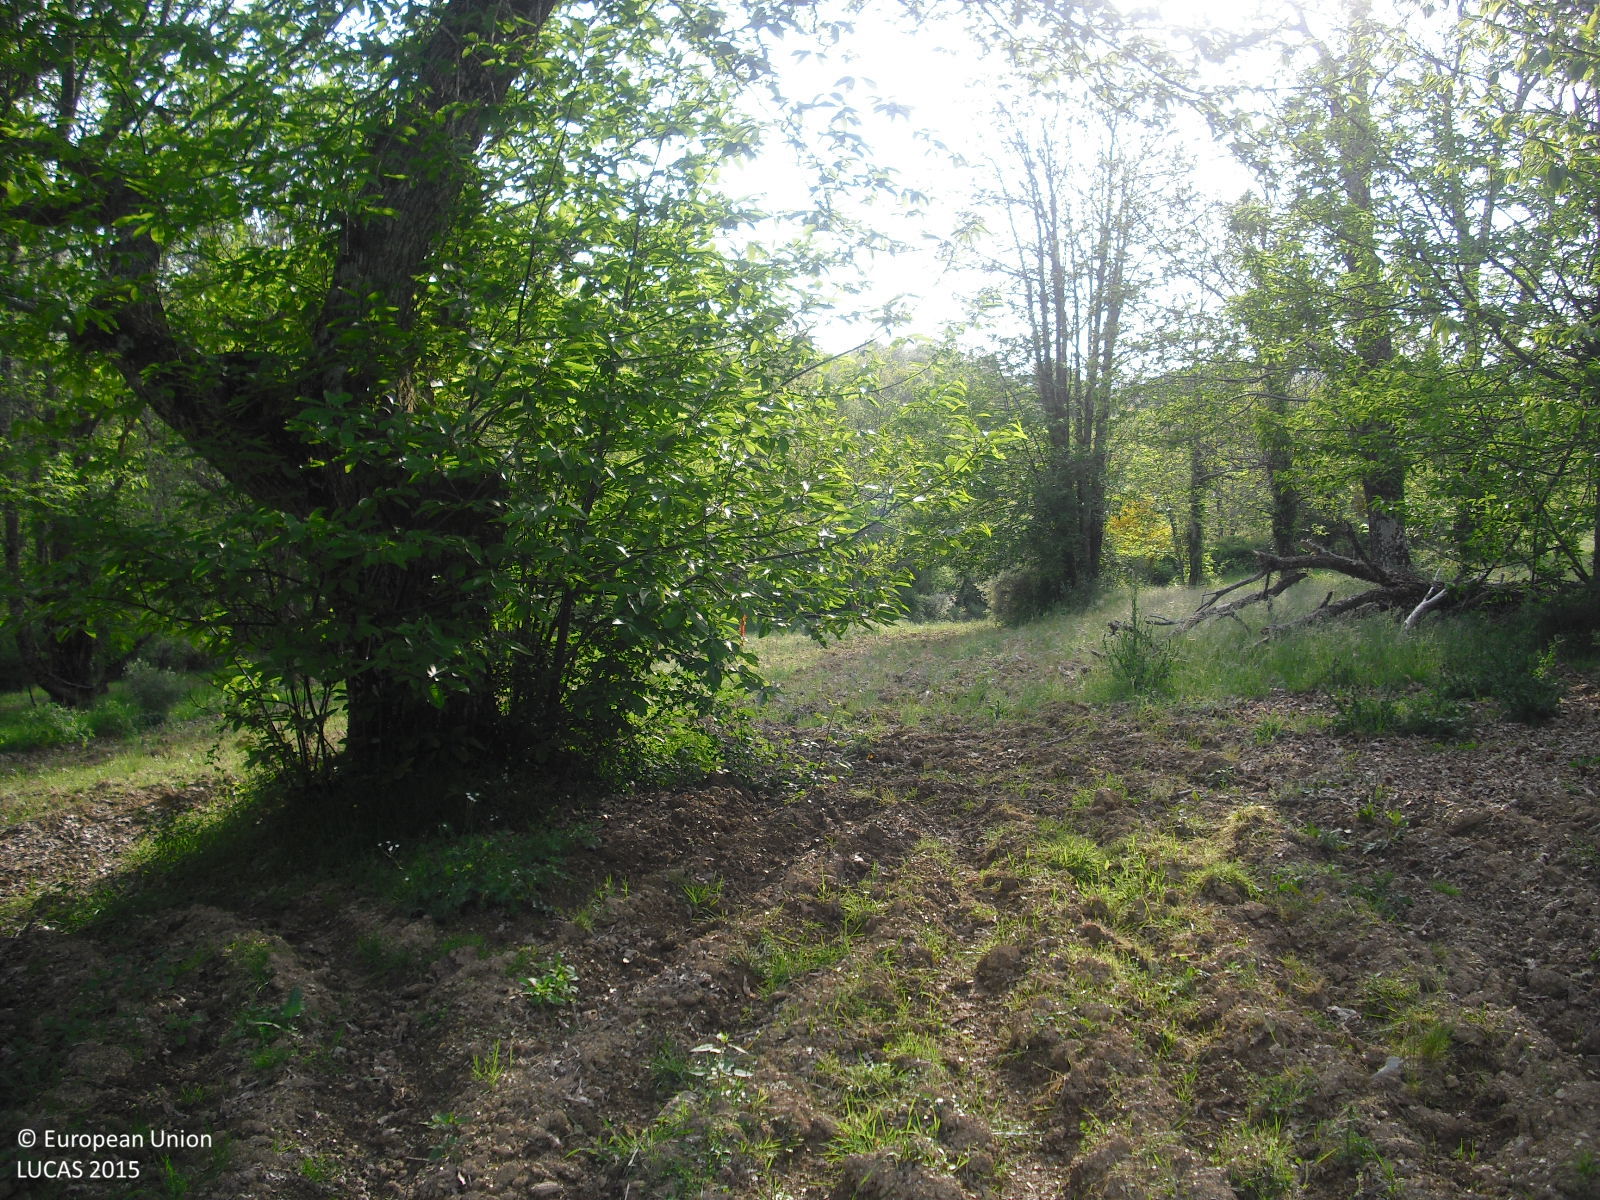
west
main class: Cropland
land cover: Nuts trees
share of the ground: 50 - 75 %
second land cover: Grassland without tree/shrub cover
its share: 50 - 75 %
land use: Agriculture (excluding fallow land and kitchen gardens)
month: May
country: ES
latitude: 41.9672
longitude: -7.2751
